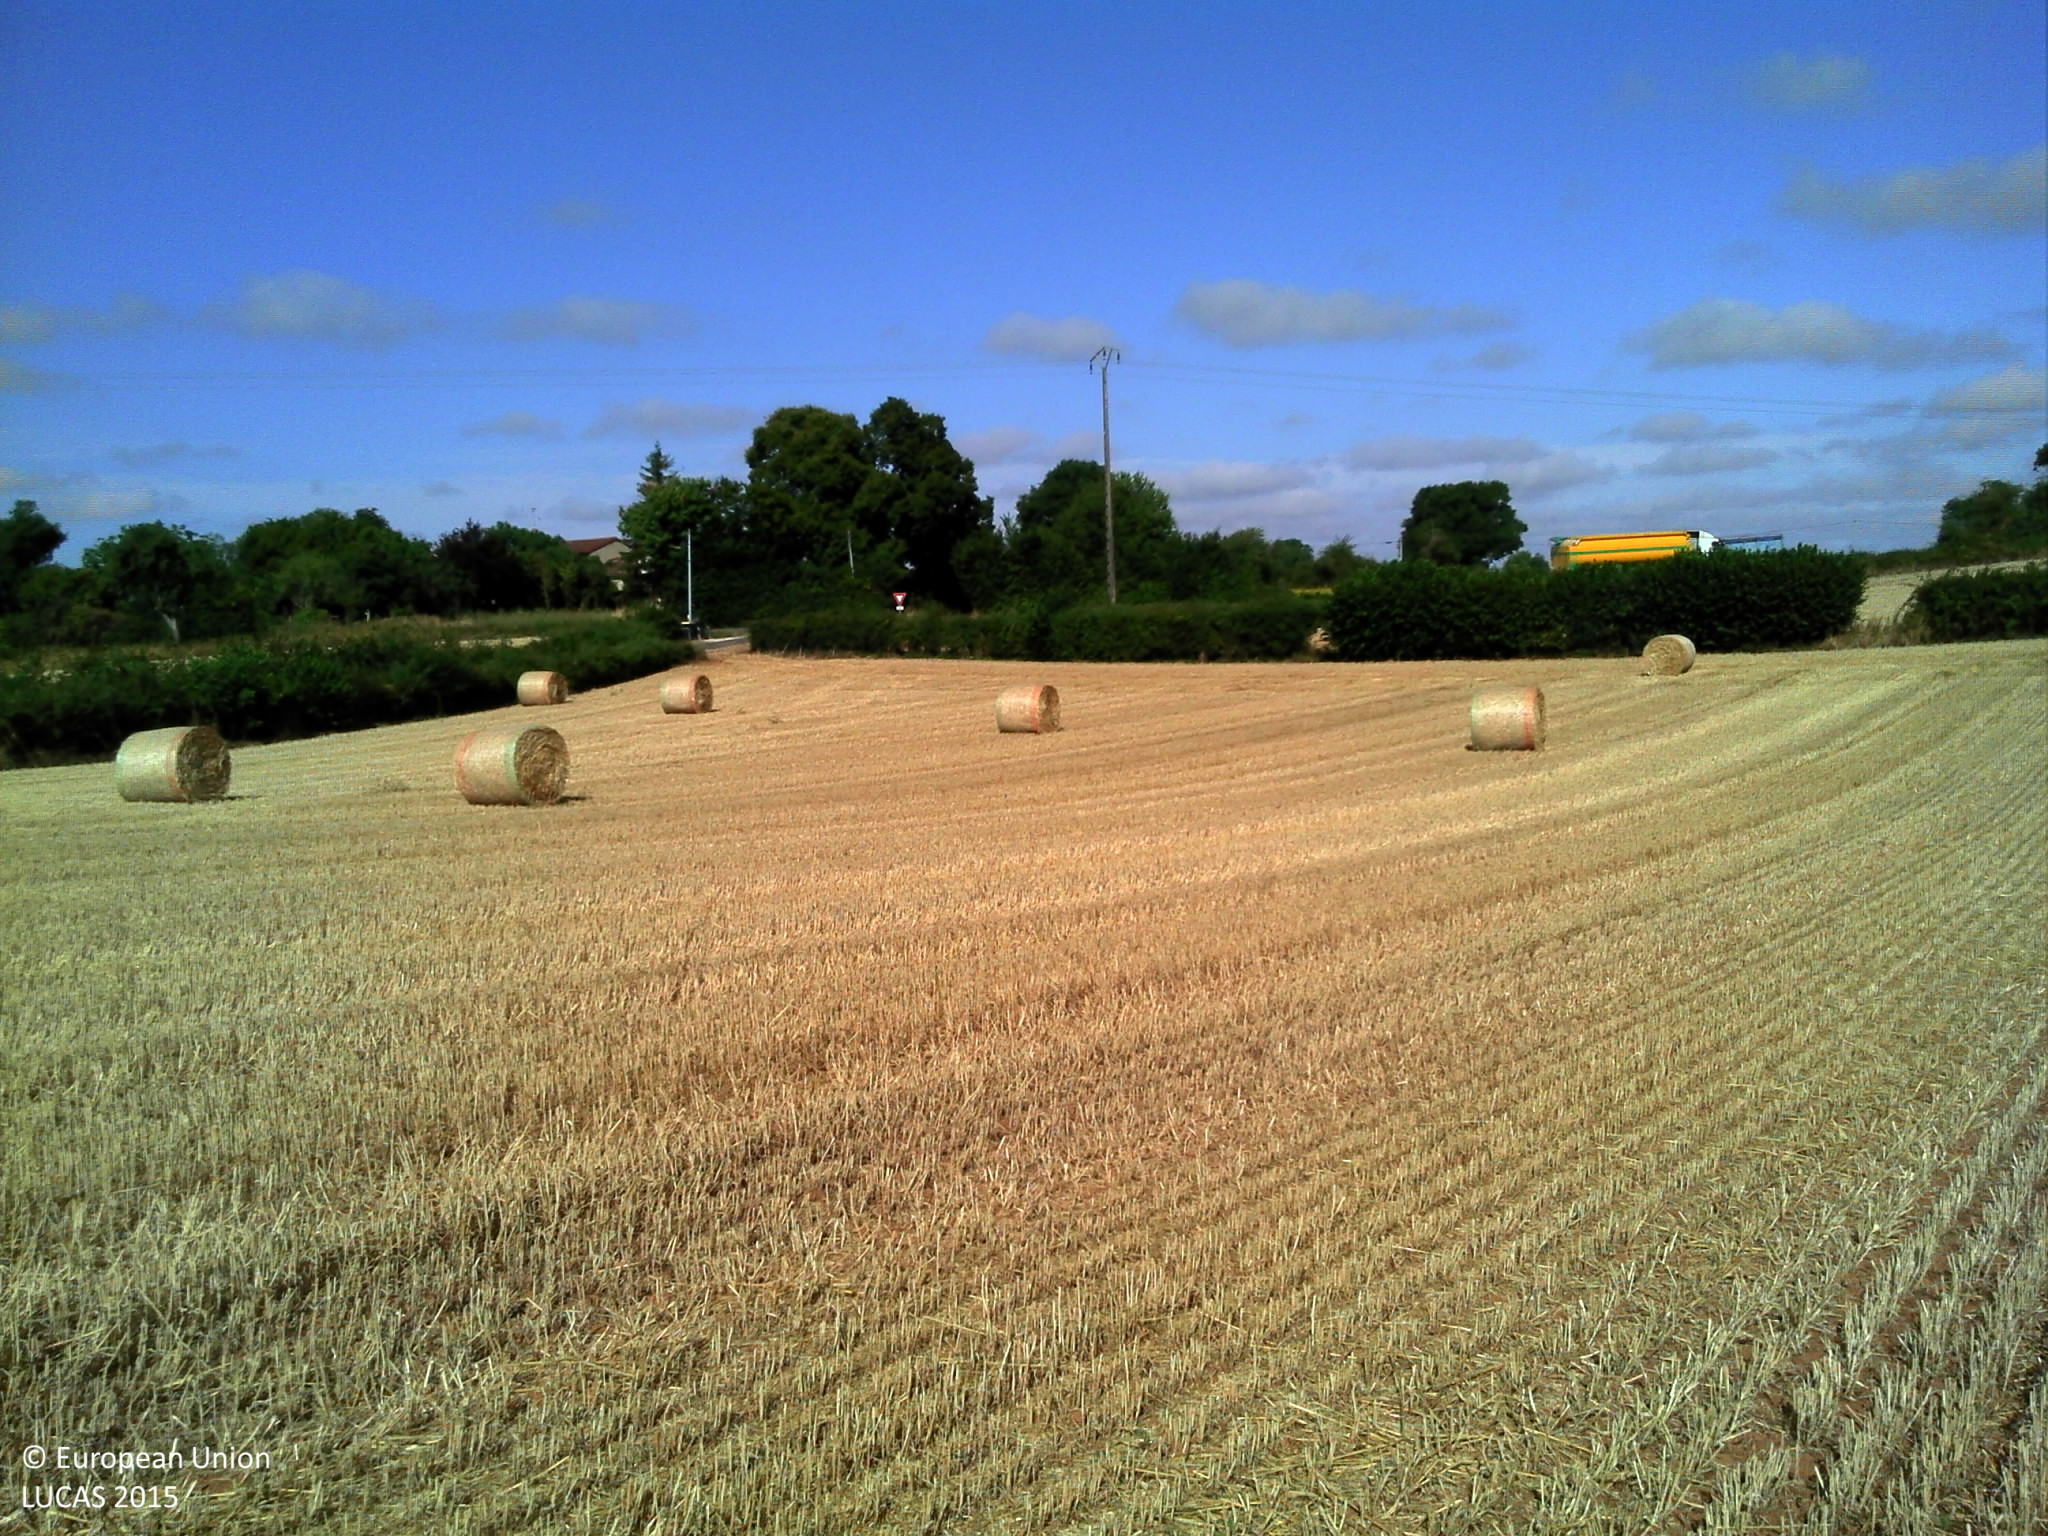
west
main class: Cropland
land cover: Common wheat
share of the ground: > 75 %
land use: Agriculture (excluding fallow land and kitchen gardens)
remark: Harvested field
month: July
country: FR
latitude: 46.2027
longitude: 0.5364
